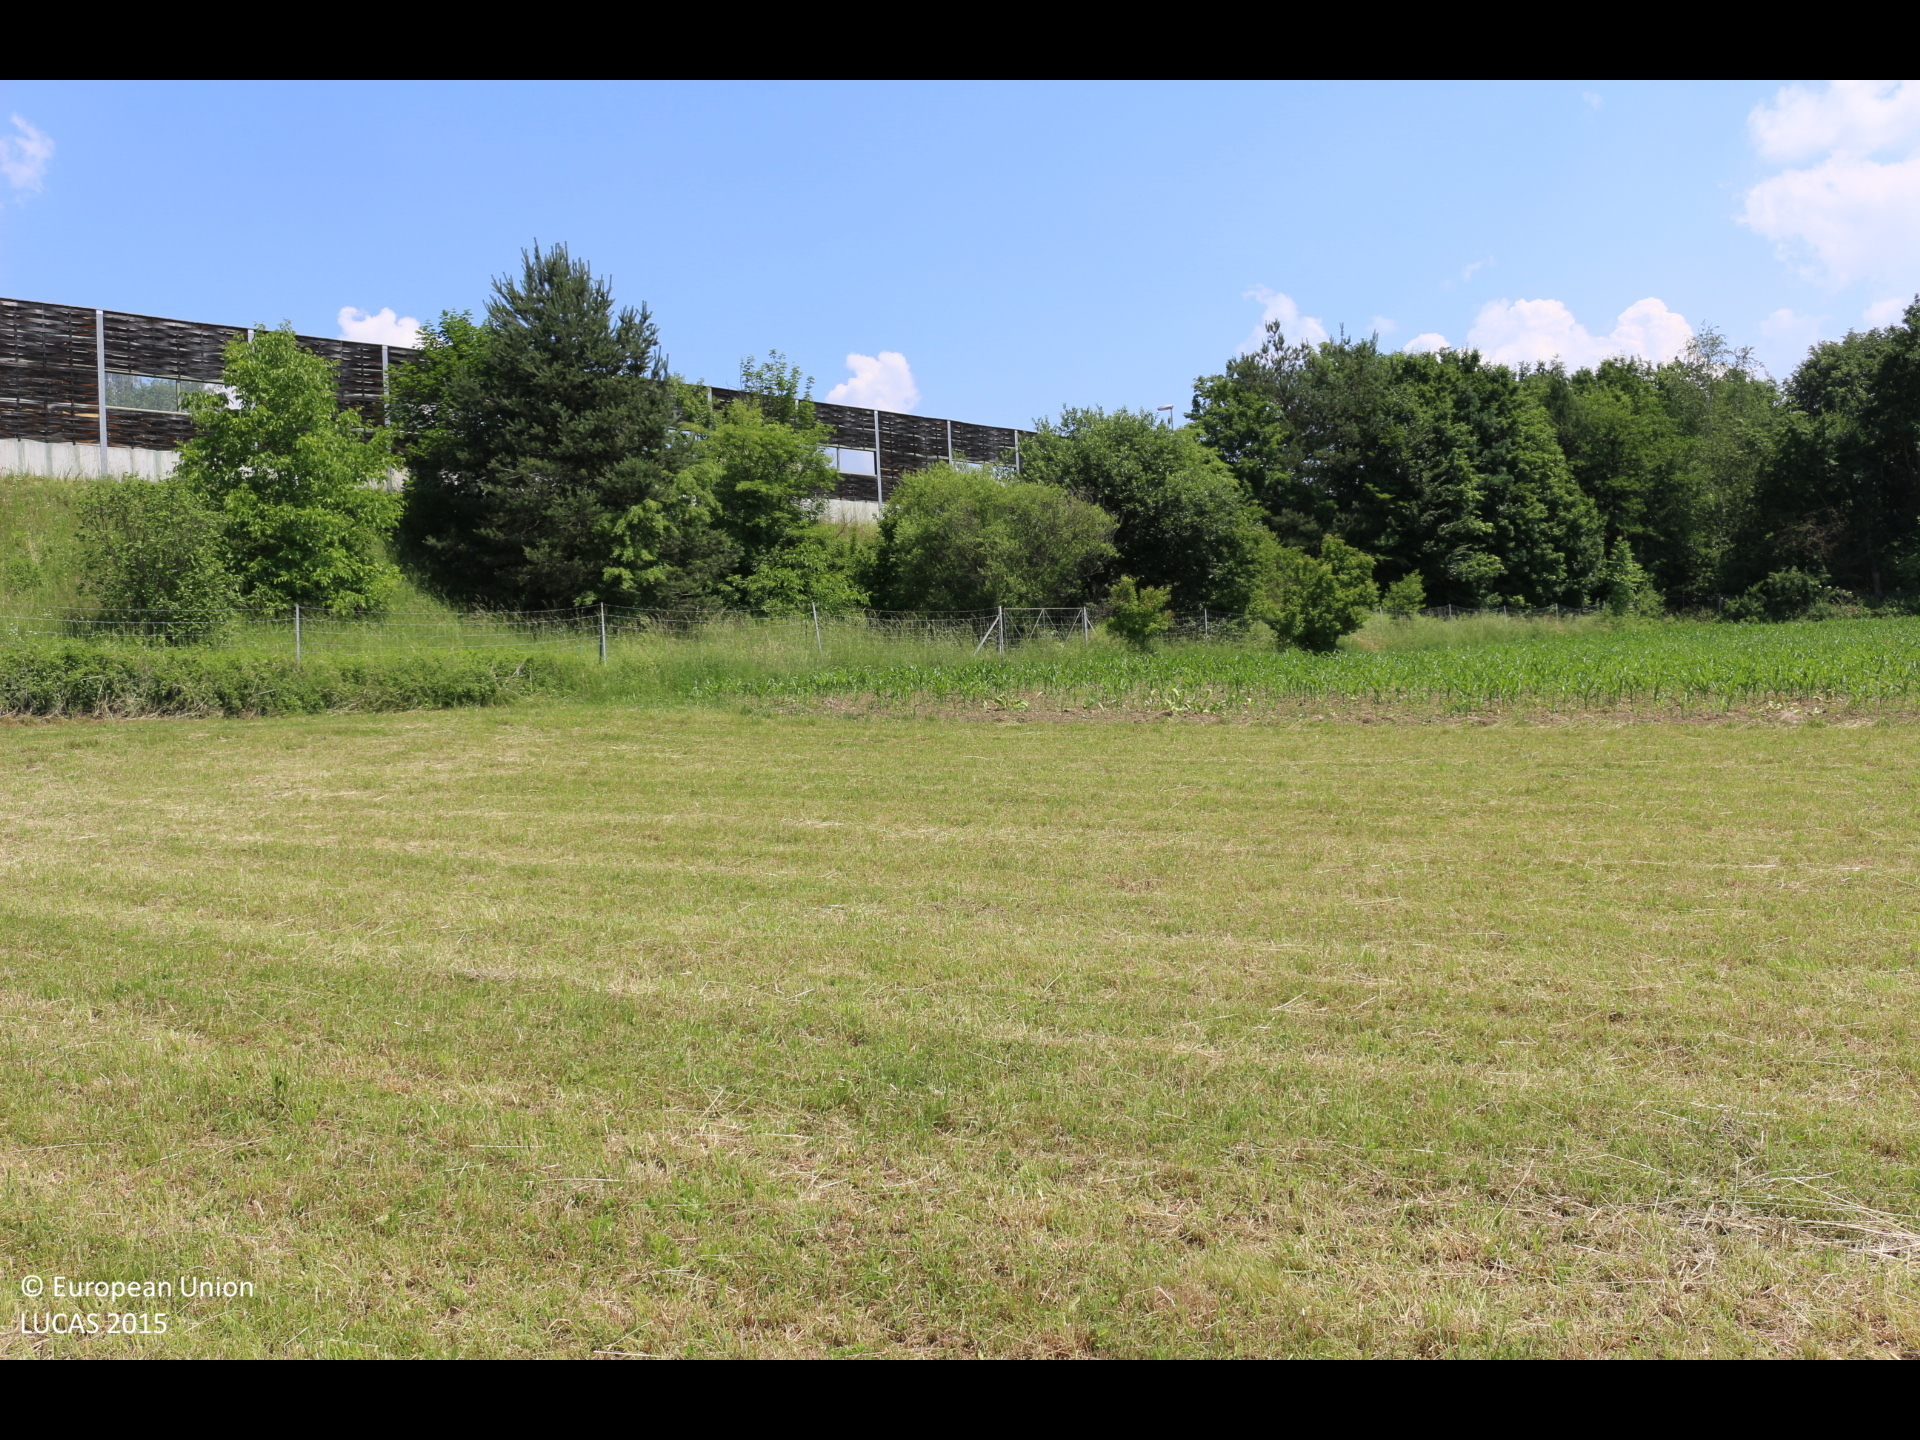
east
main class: Grassland
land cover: Grassland without tree/shrub cover
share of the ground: > 75 %
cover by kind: herbaceous plants 100 %
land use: Agriculture (excluding fallow land and kitchen gardens)
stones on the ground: < 10 %
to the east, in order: Grassland without tree/shrub cover; Maize; Fences; Broadleaved woodland; Pine dominated mixed woodland; Artificial constructions; Paved roads, cycling and walking lanes; Grass margins; Paved roads, cycling and walking lanes; Broadleaved woodland; Grassland with sparse tree/shrub cover
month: June
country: AT
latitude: 46.6198
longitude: 13.9802
